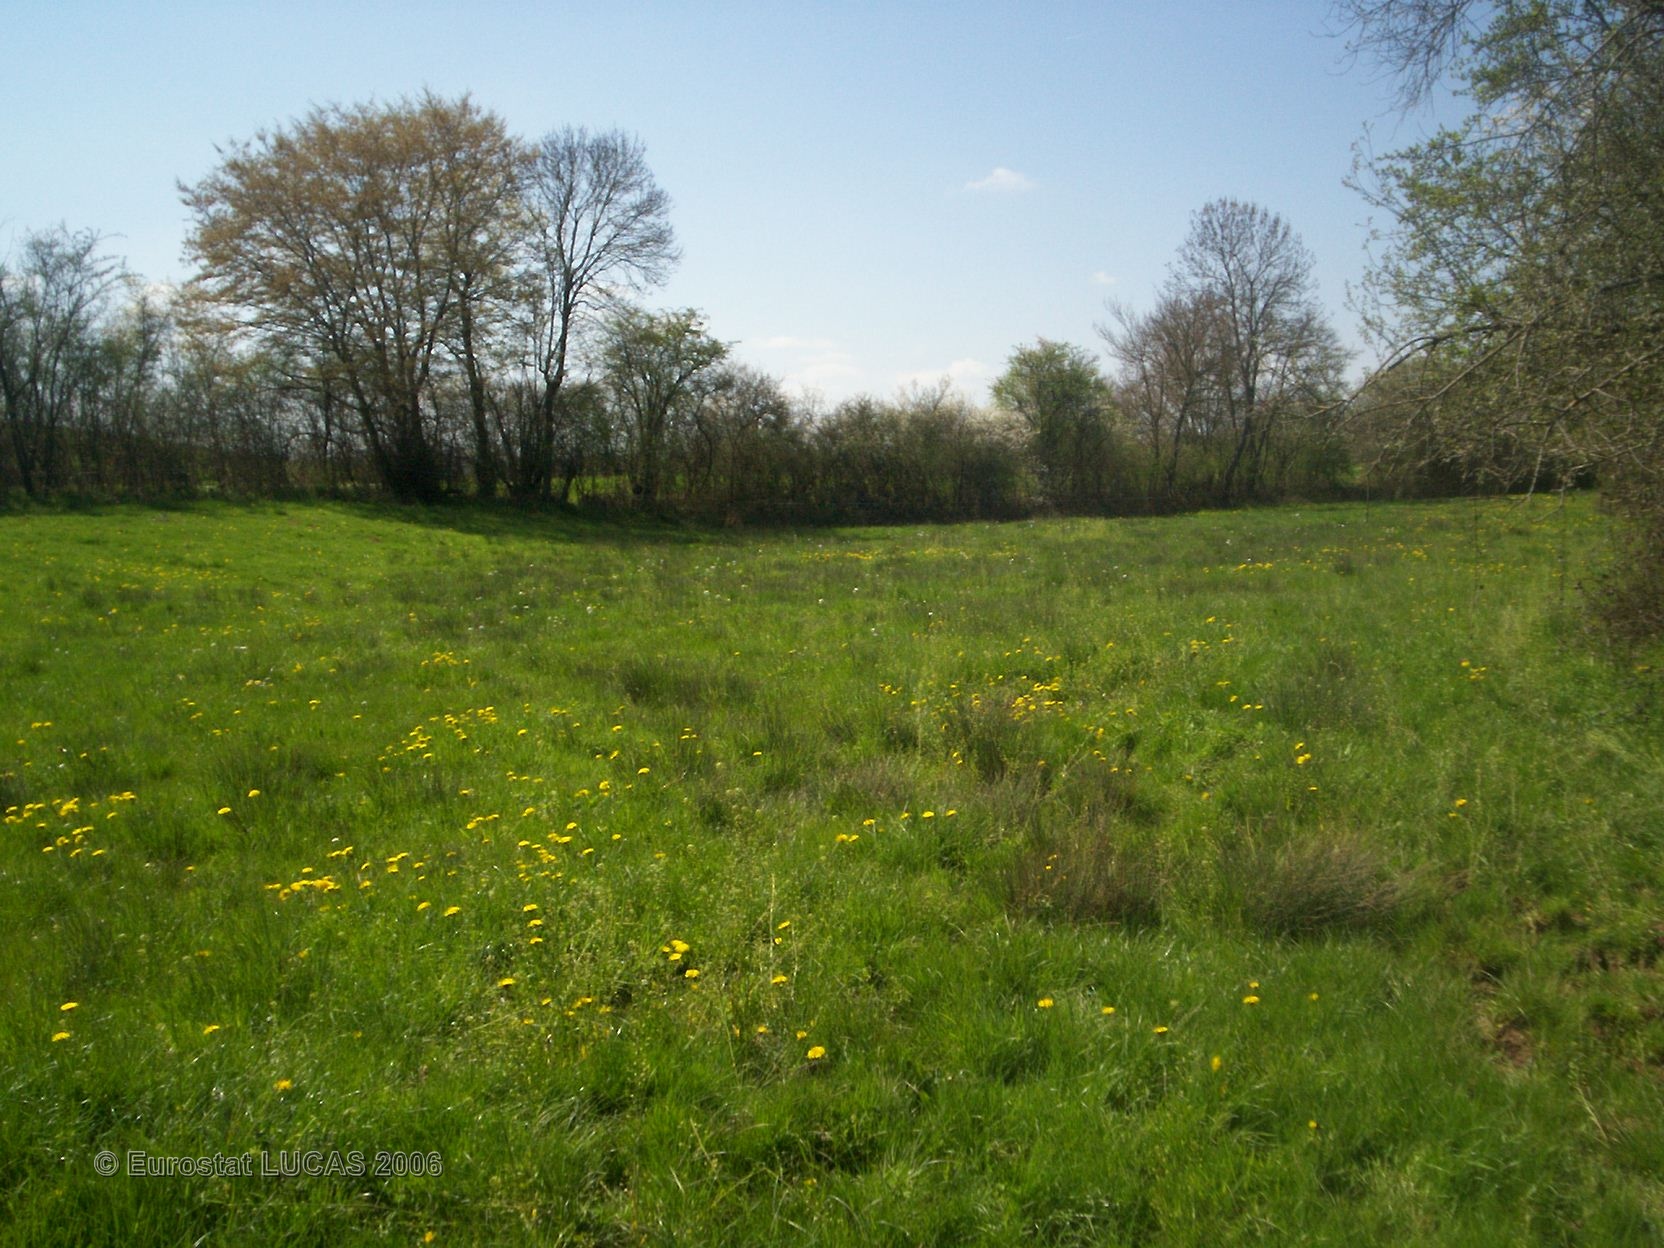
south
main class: Grassland
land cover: Grassland without tree/shrub cover
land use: Agriculture (excluding fallow land and kitchen gardens)
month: April
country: FR
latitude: 46.6335
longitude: 3.0871
